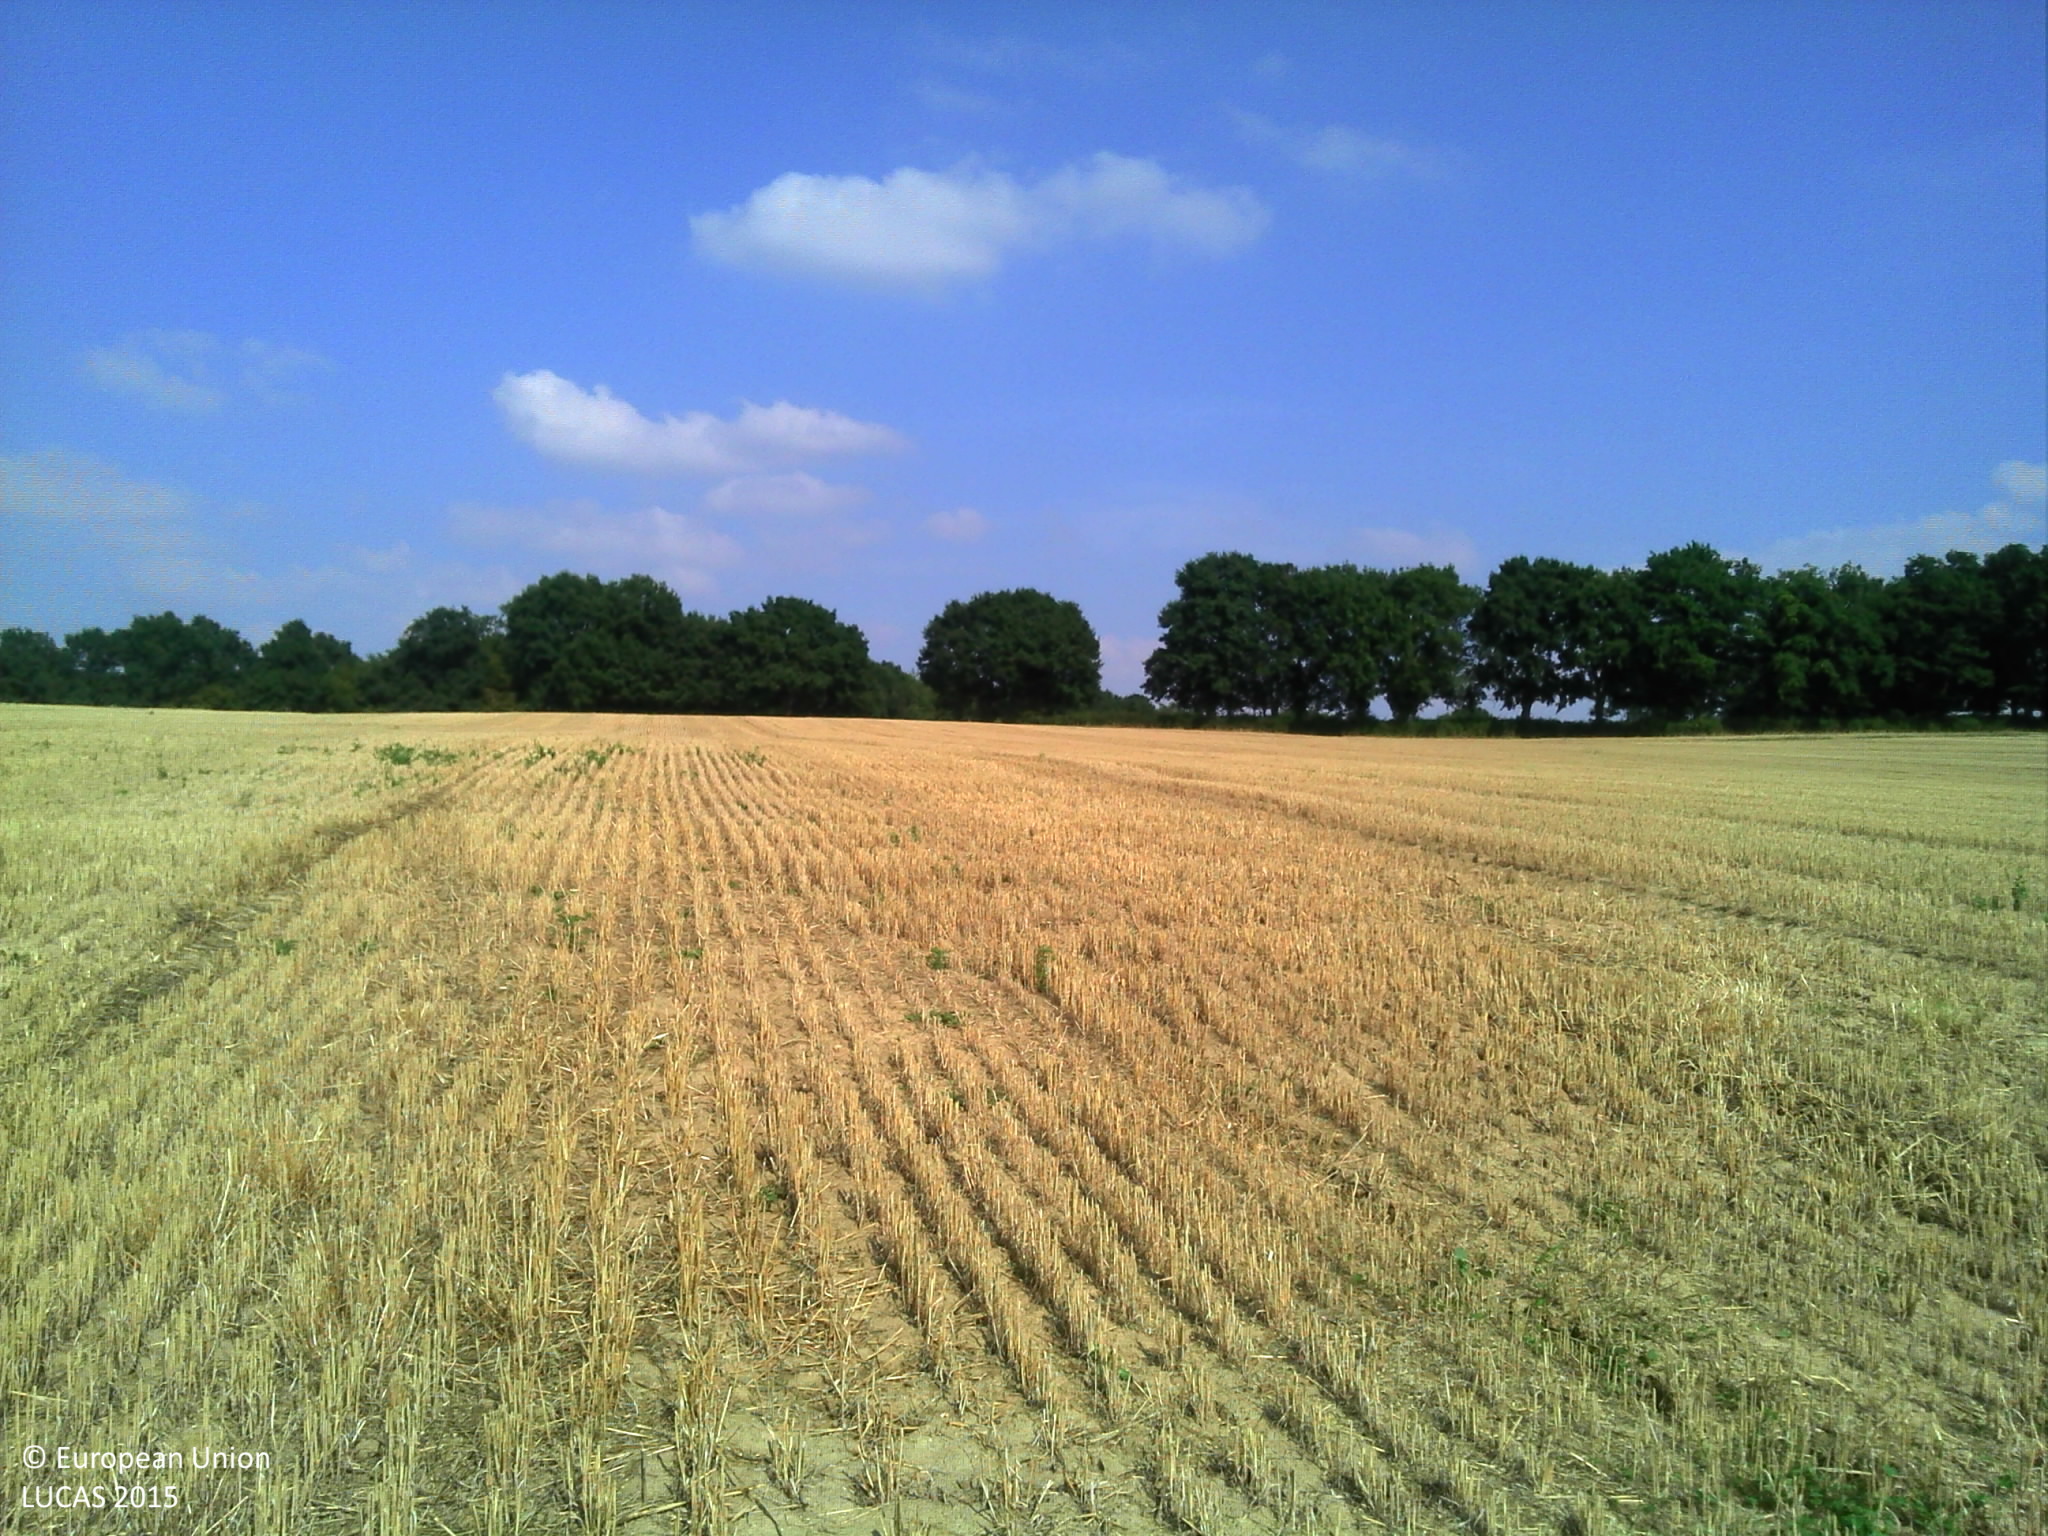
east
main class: Cropland
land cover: Common wheat
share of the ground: > 75 %
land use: Agriculture (excluding fallow land and kitchen gardens)
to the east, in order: Common wheat; Broadleaved woodland; Managed hedges; Fences; Grassland without tree/shrub cover
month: August
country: FR
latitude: 46.3952
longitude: 3.6139
